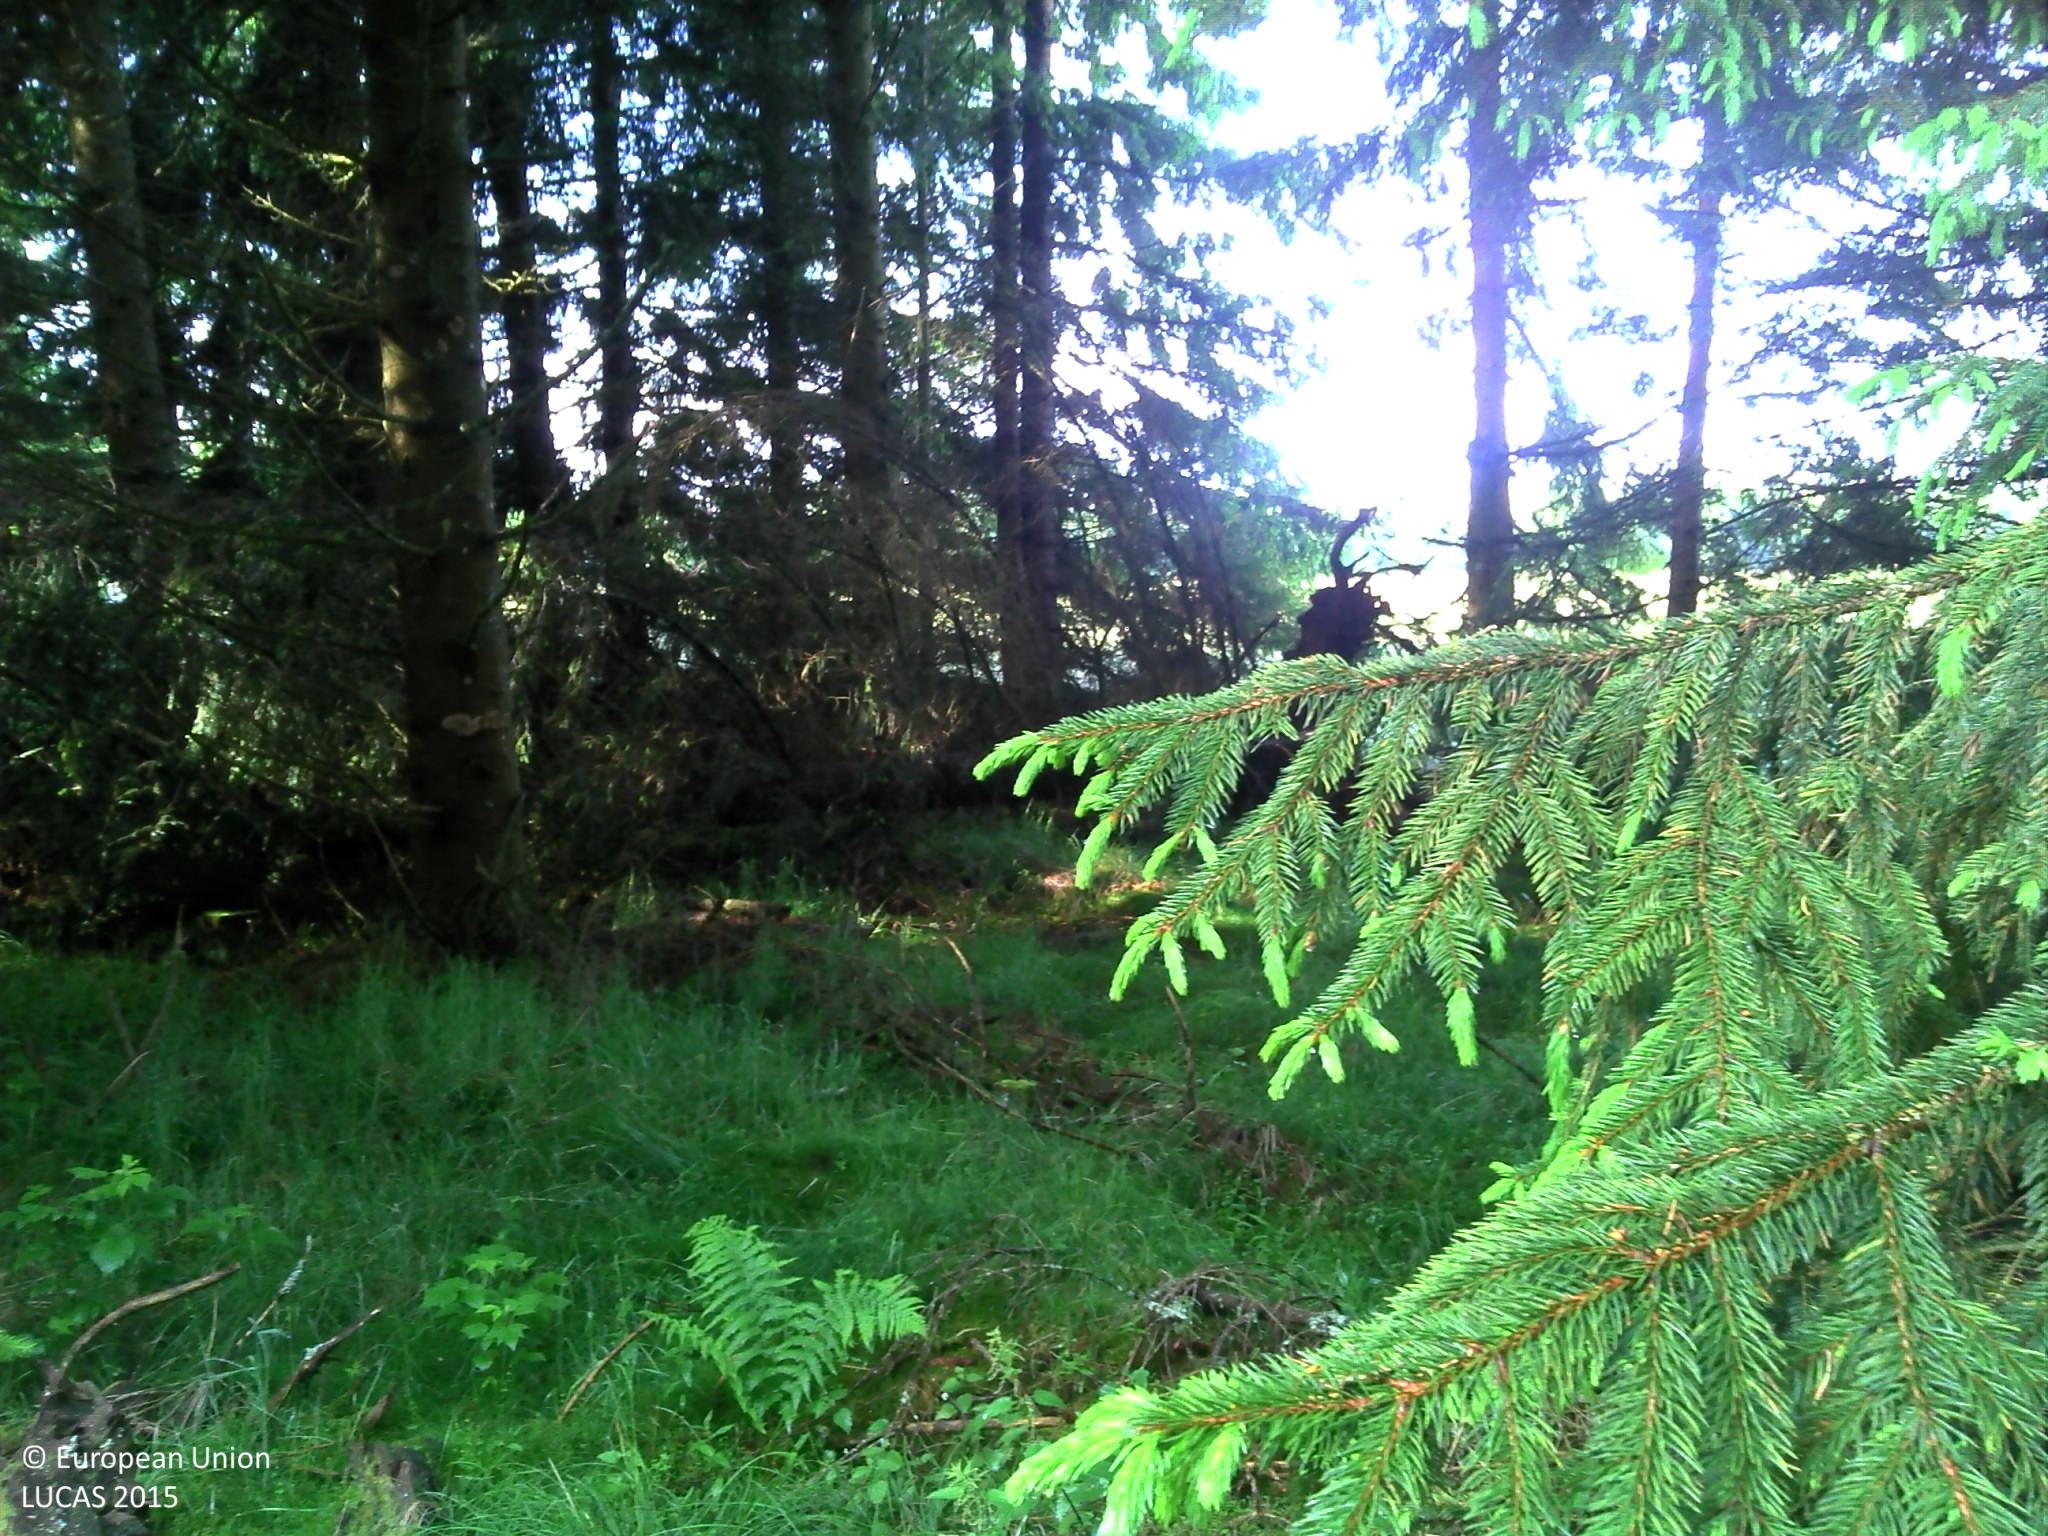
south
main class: Woodland
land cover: Spruce dominated coniferous woodland
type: alpine coniferous forest
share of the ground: > 75 %
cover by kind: coniferous forest trees 80 %, shrubs 10 %, herbaceous plants 10 %
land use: Forestry
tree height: > 5 m
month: June
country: FR
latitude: 45.1723
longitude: 2.8629
